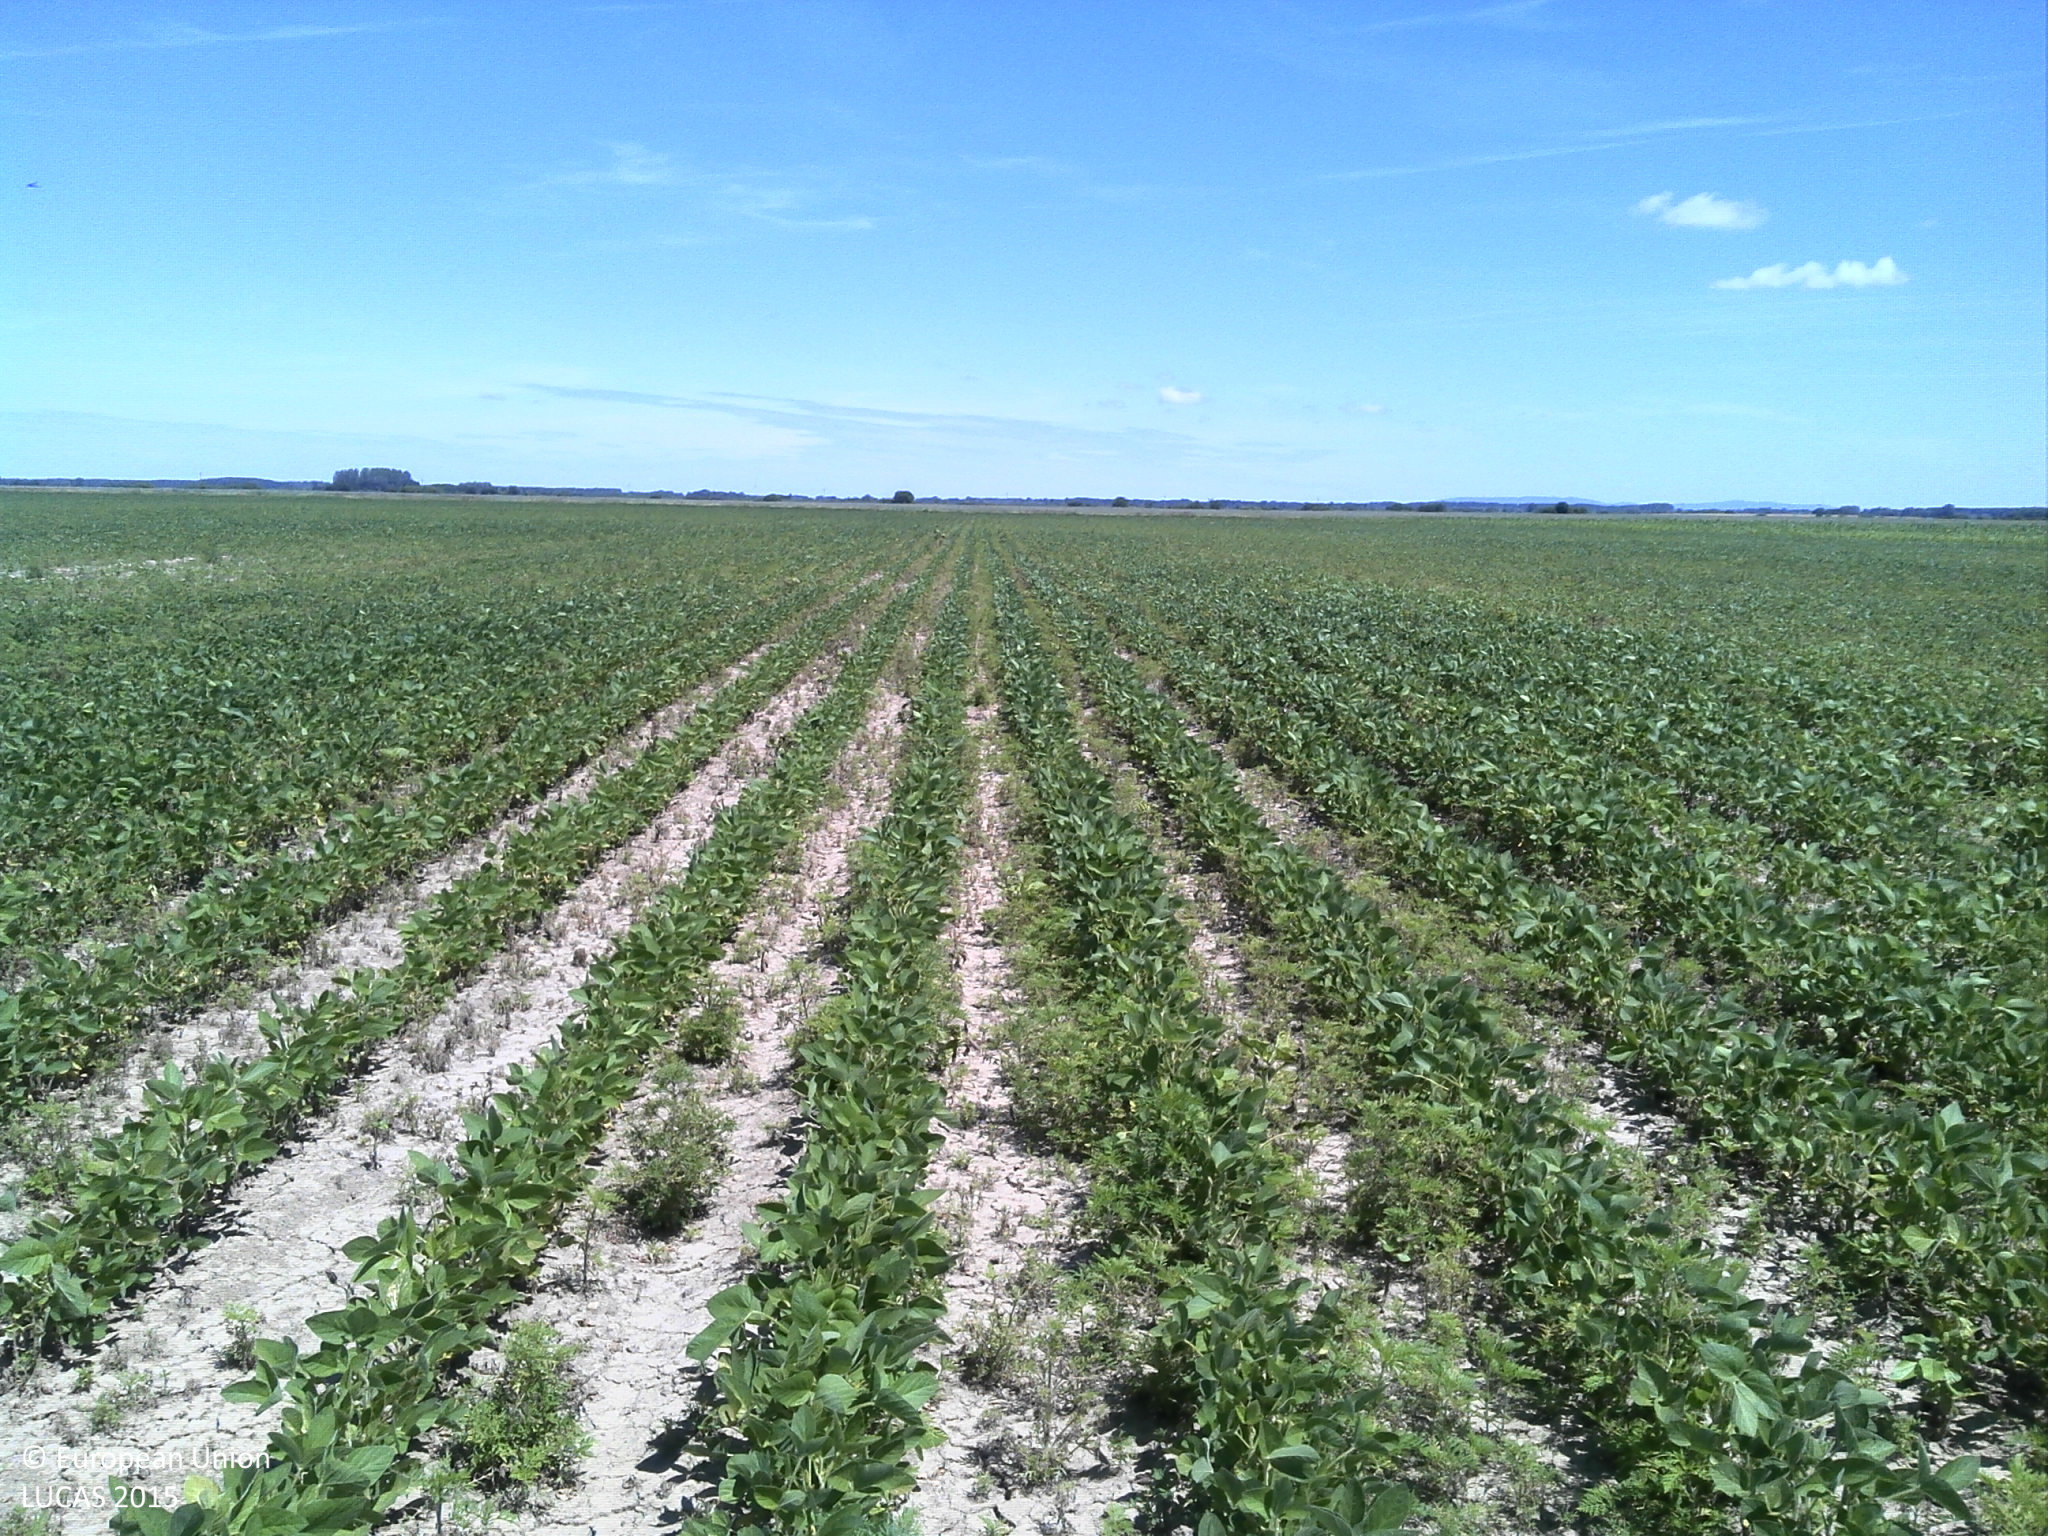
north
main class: Cropland
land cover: Soya
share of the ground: 50 - 75 %
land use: Agriculture (excluding fallow land and kitchen gardens)
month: June
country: HR
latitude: 45.7446
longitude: 17.9866
